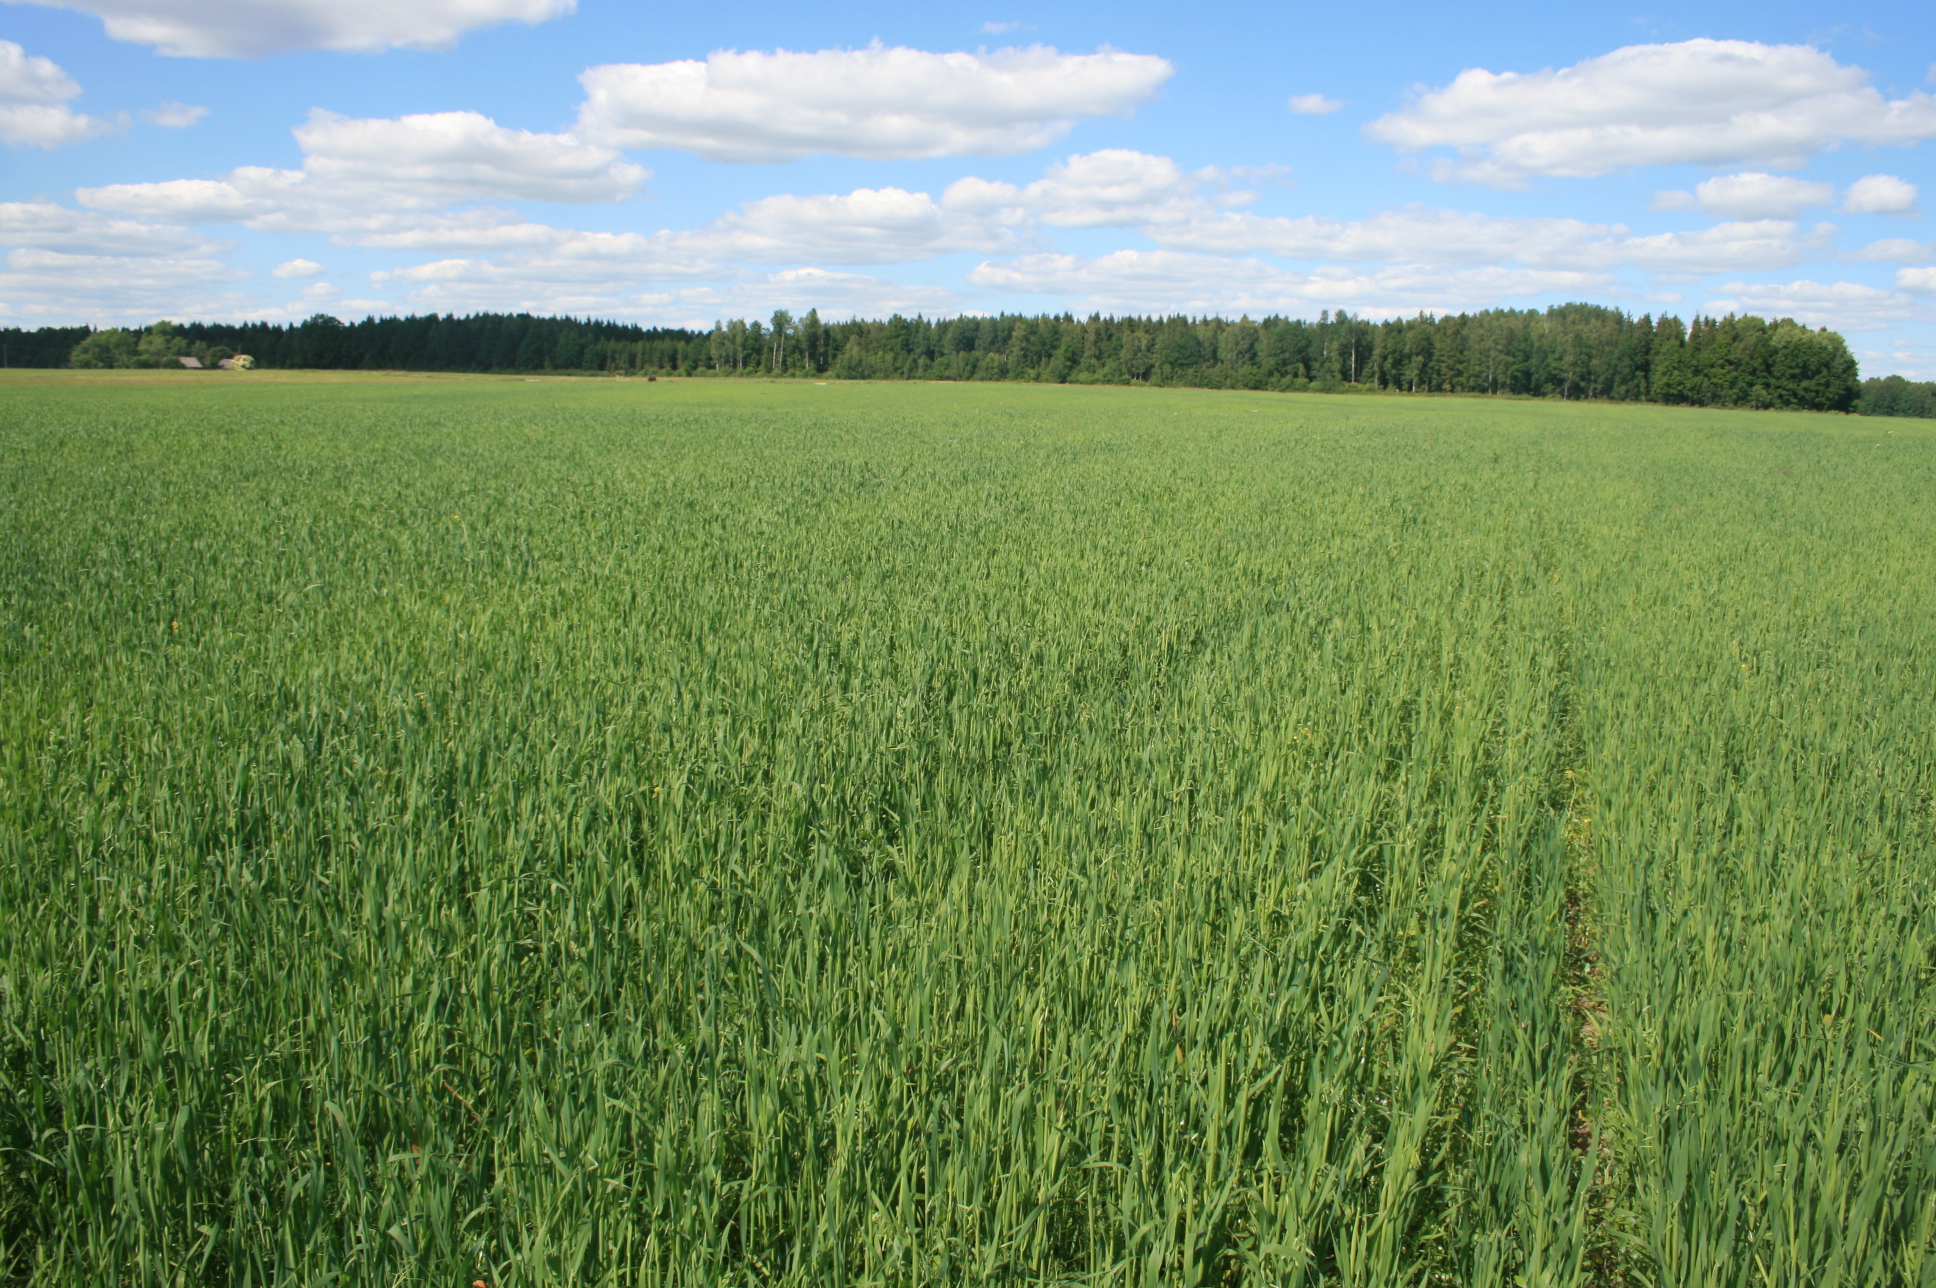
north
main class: Cropland
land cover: Other leguminous and mixtures for fodder
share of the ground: > 75 %
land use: Agriculture (excluding fallow land and kitchen gardens)
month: June
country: LT
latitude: 55.3941
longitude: 22.1014
